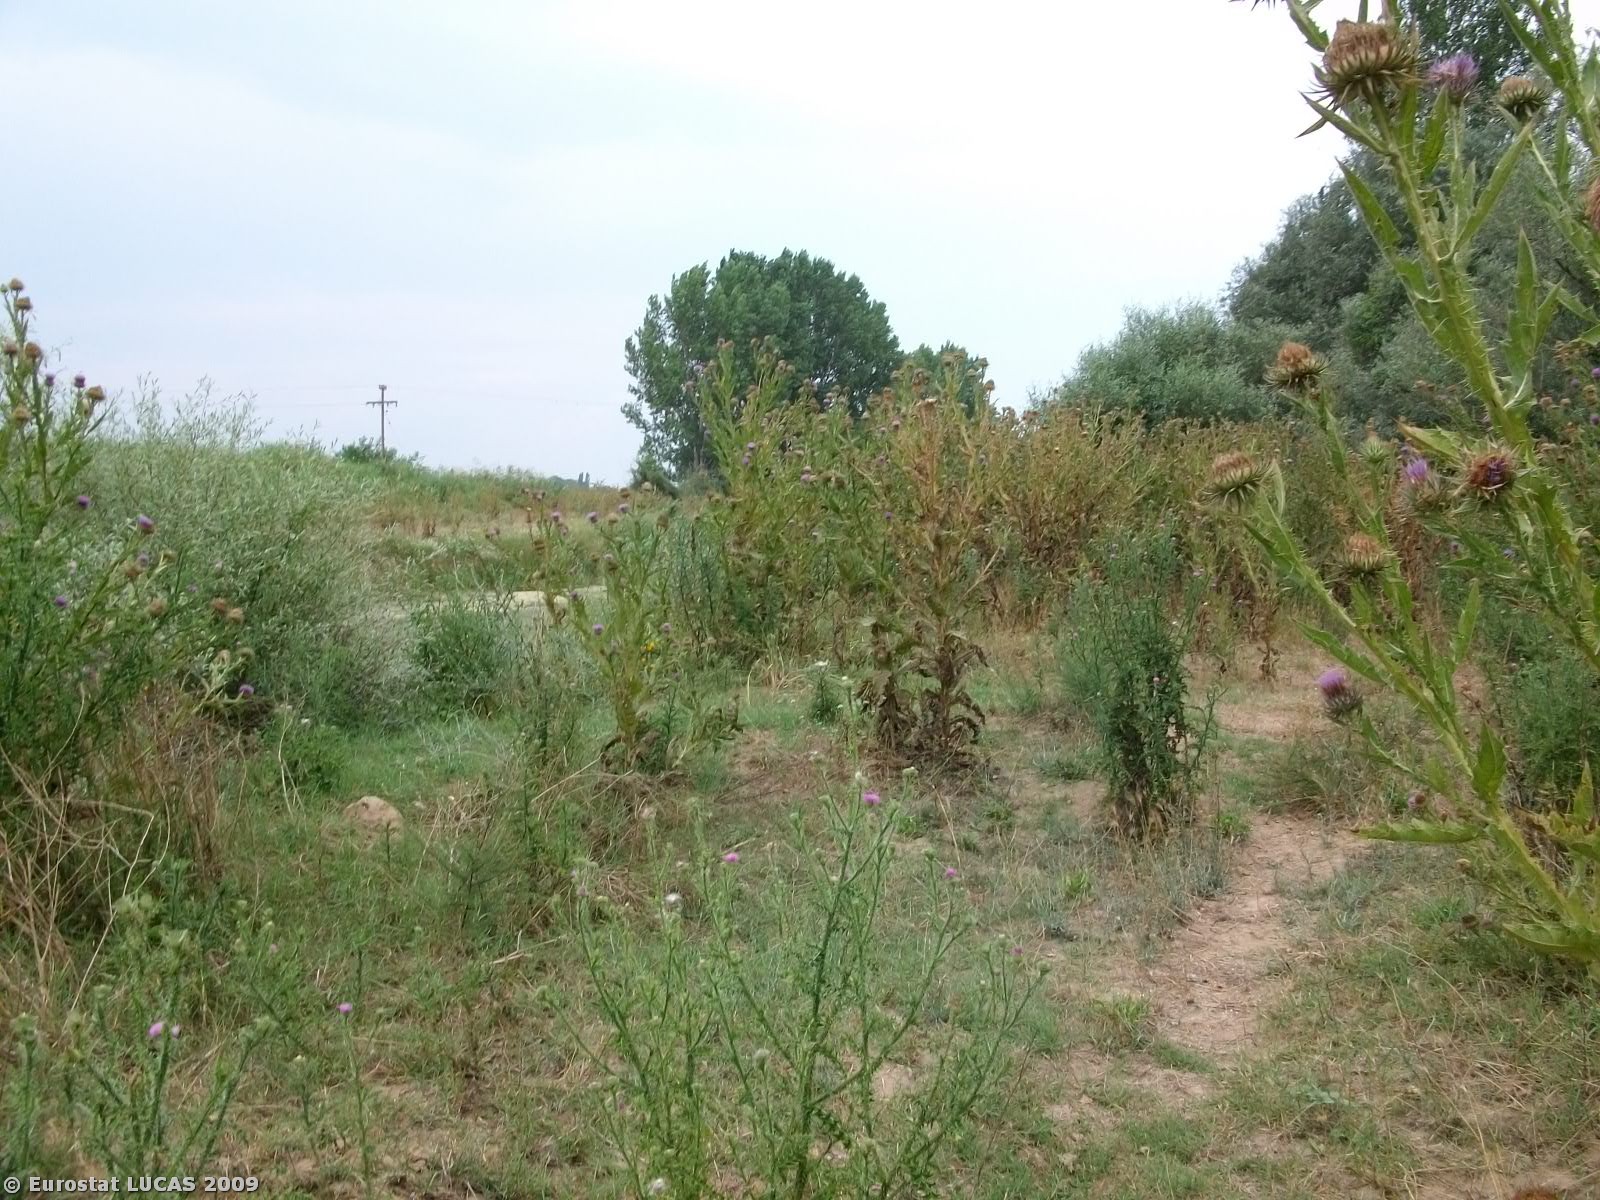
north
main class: Woodland
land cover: Broadleaved woodland
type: broadleaved evergreen forest
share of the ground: > 75 %
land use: Forestry
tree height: > 5 m
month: July
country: GR
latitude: 40.9168
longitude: 26.1999
